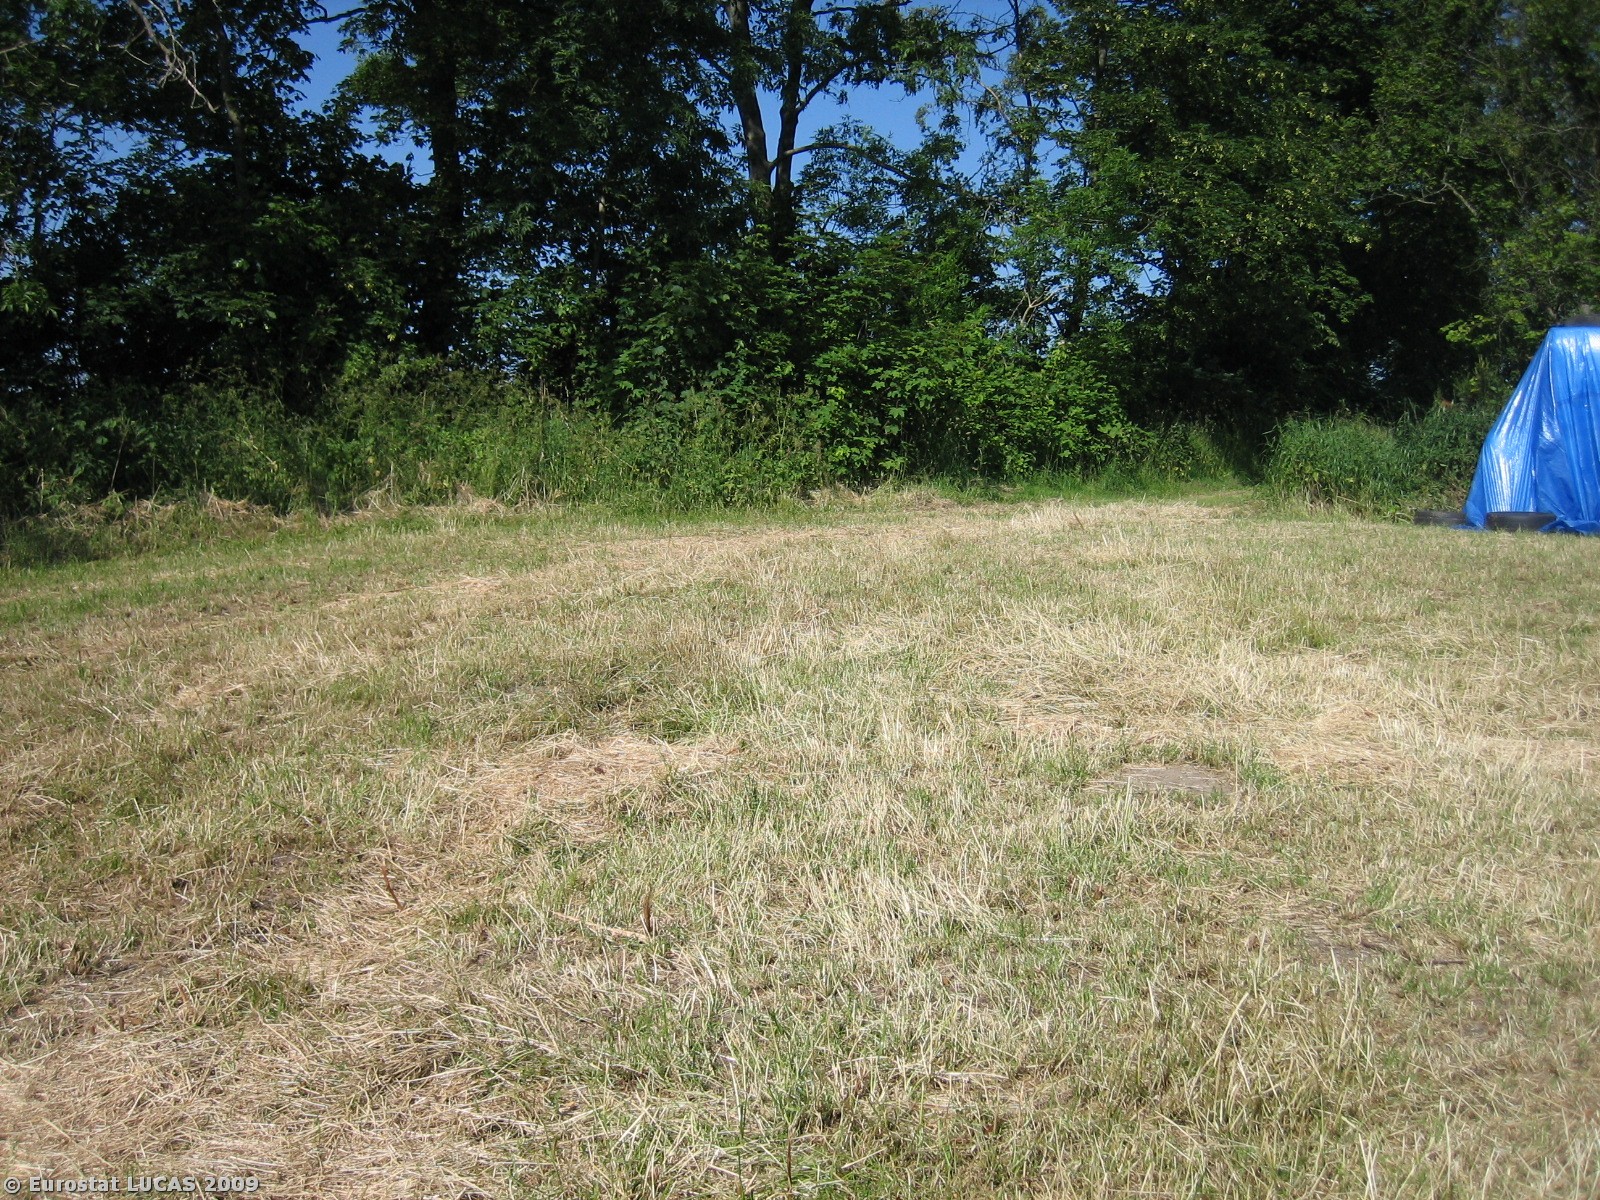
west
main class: Cropland
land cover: Temporary grasslands
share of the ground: > 75 %
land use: Agriculture (excluding fallow land and kitchen gardens)
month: June
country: DK
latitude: 55.3949
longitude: 9.2902
